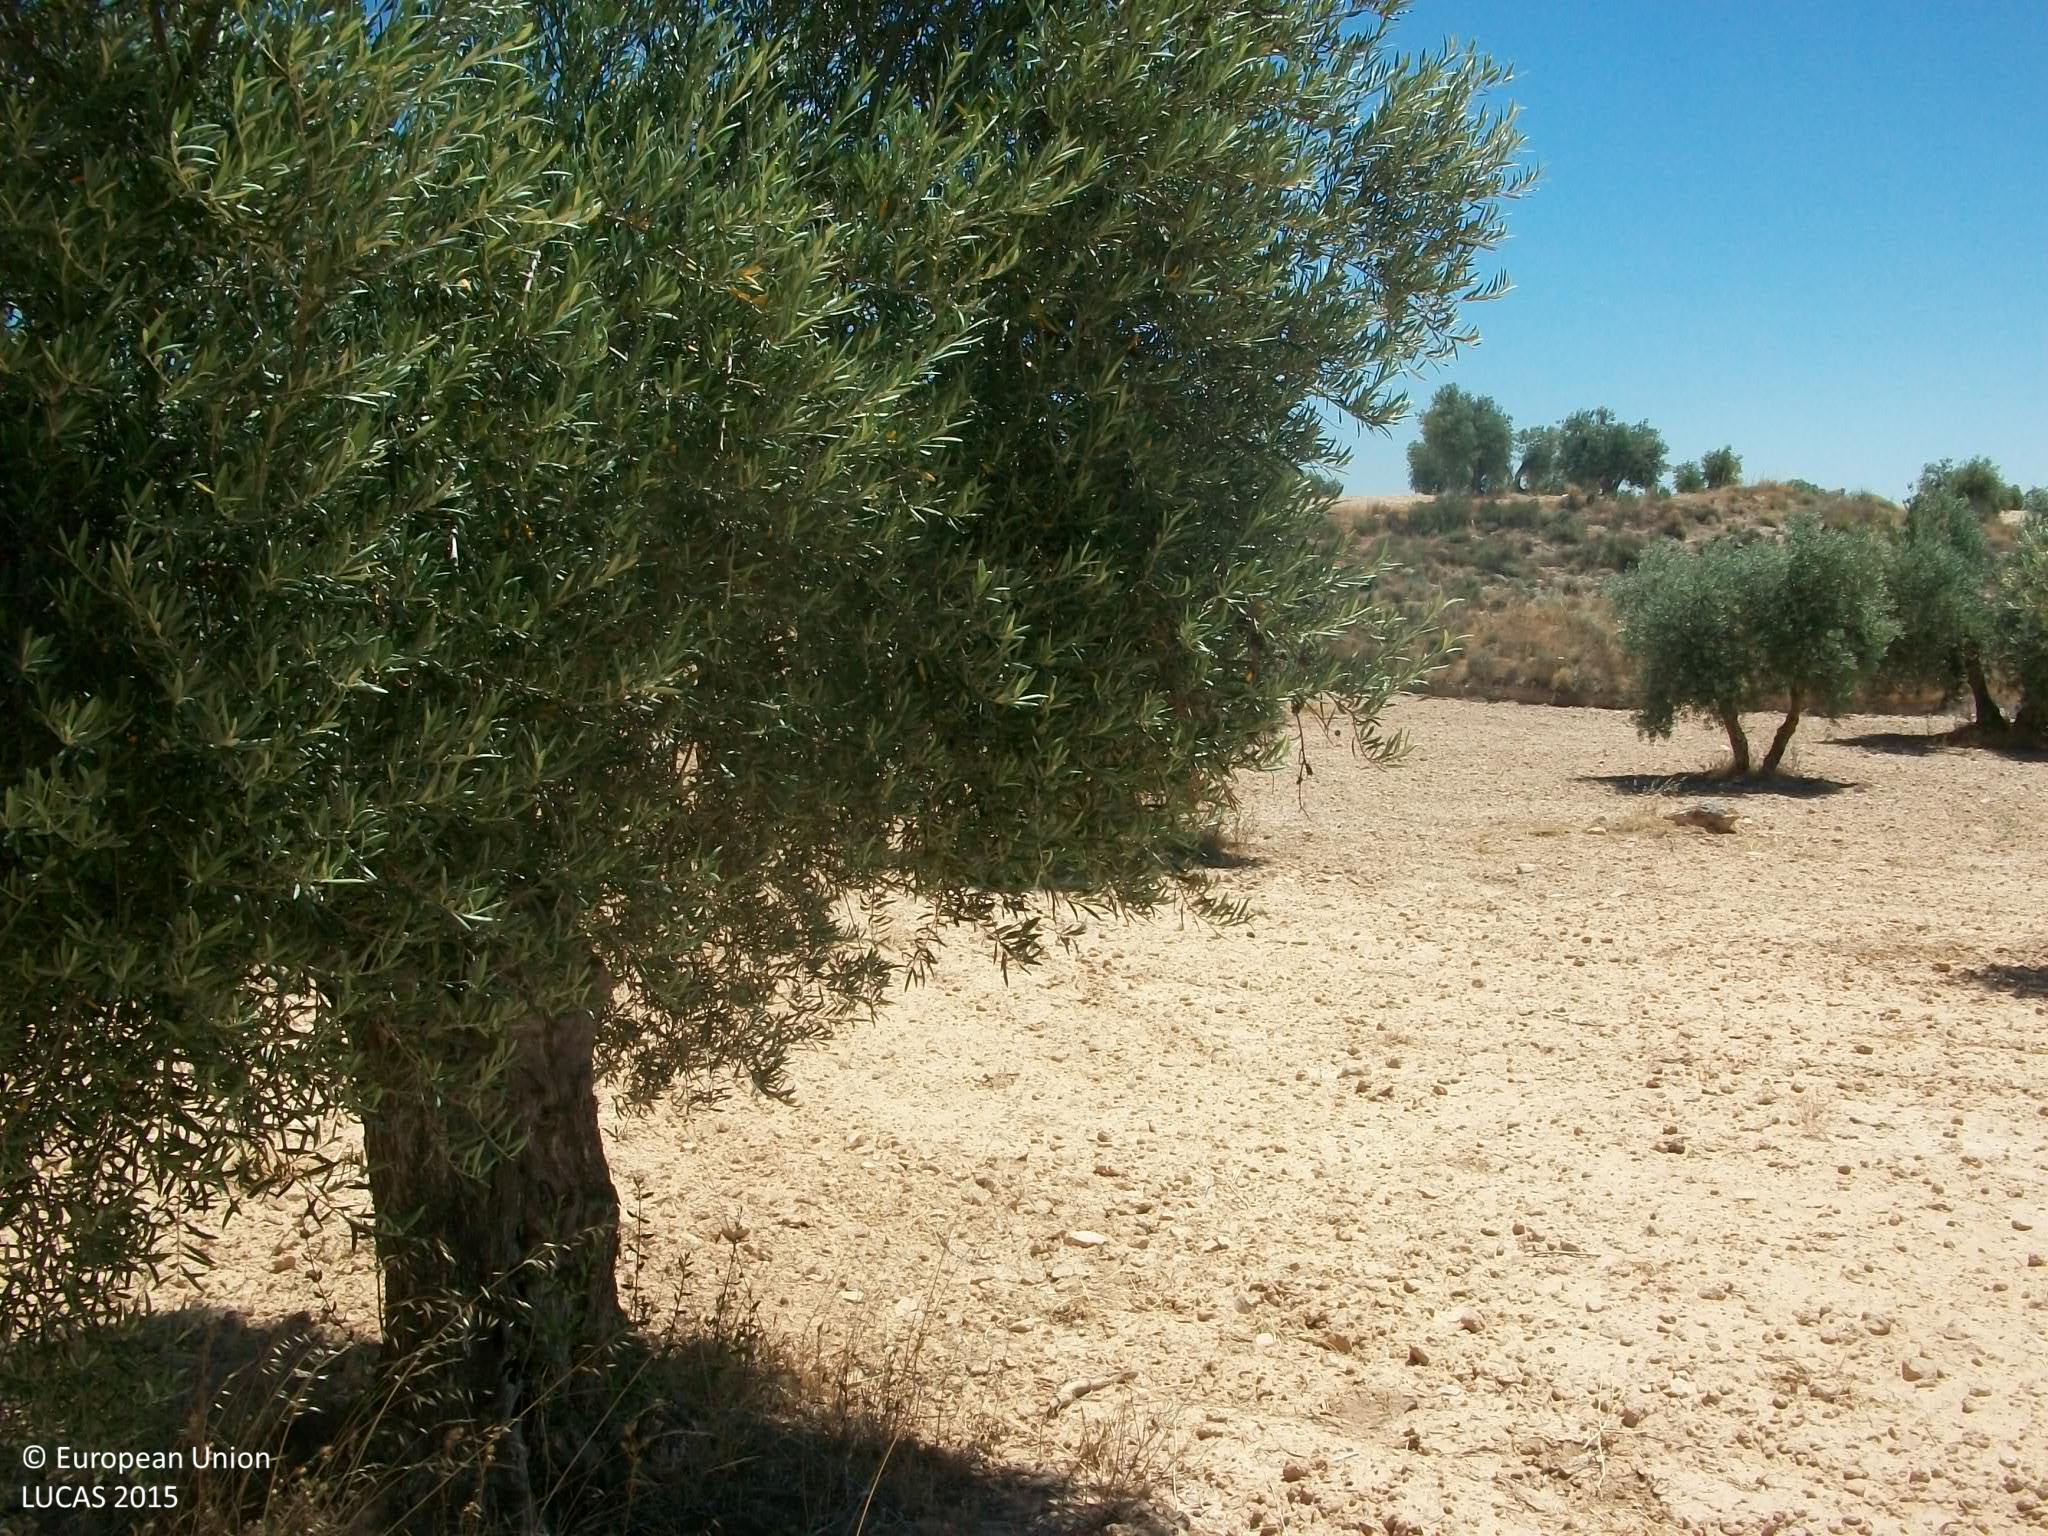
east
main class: Cropland
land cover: Olive groves
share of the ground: 25 - 50 %
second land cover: Other bare soil
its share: > 75 %
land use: Agriculture (excluding fallow land and kitchen gardens)
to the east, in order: Olive groves; Other bare soil; Shrubland without tree cover; Olive groves; Tracks; Olive groves; Other bare soil; Olive groves; Shrubland without tree cover
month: June
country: ES
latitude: 39.9085
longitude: -3.6817
